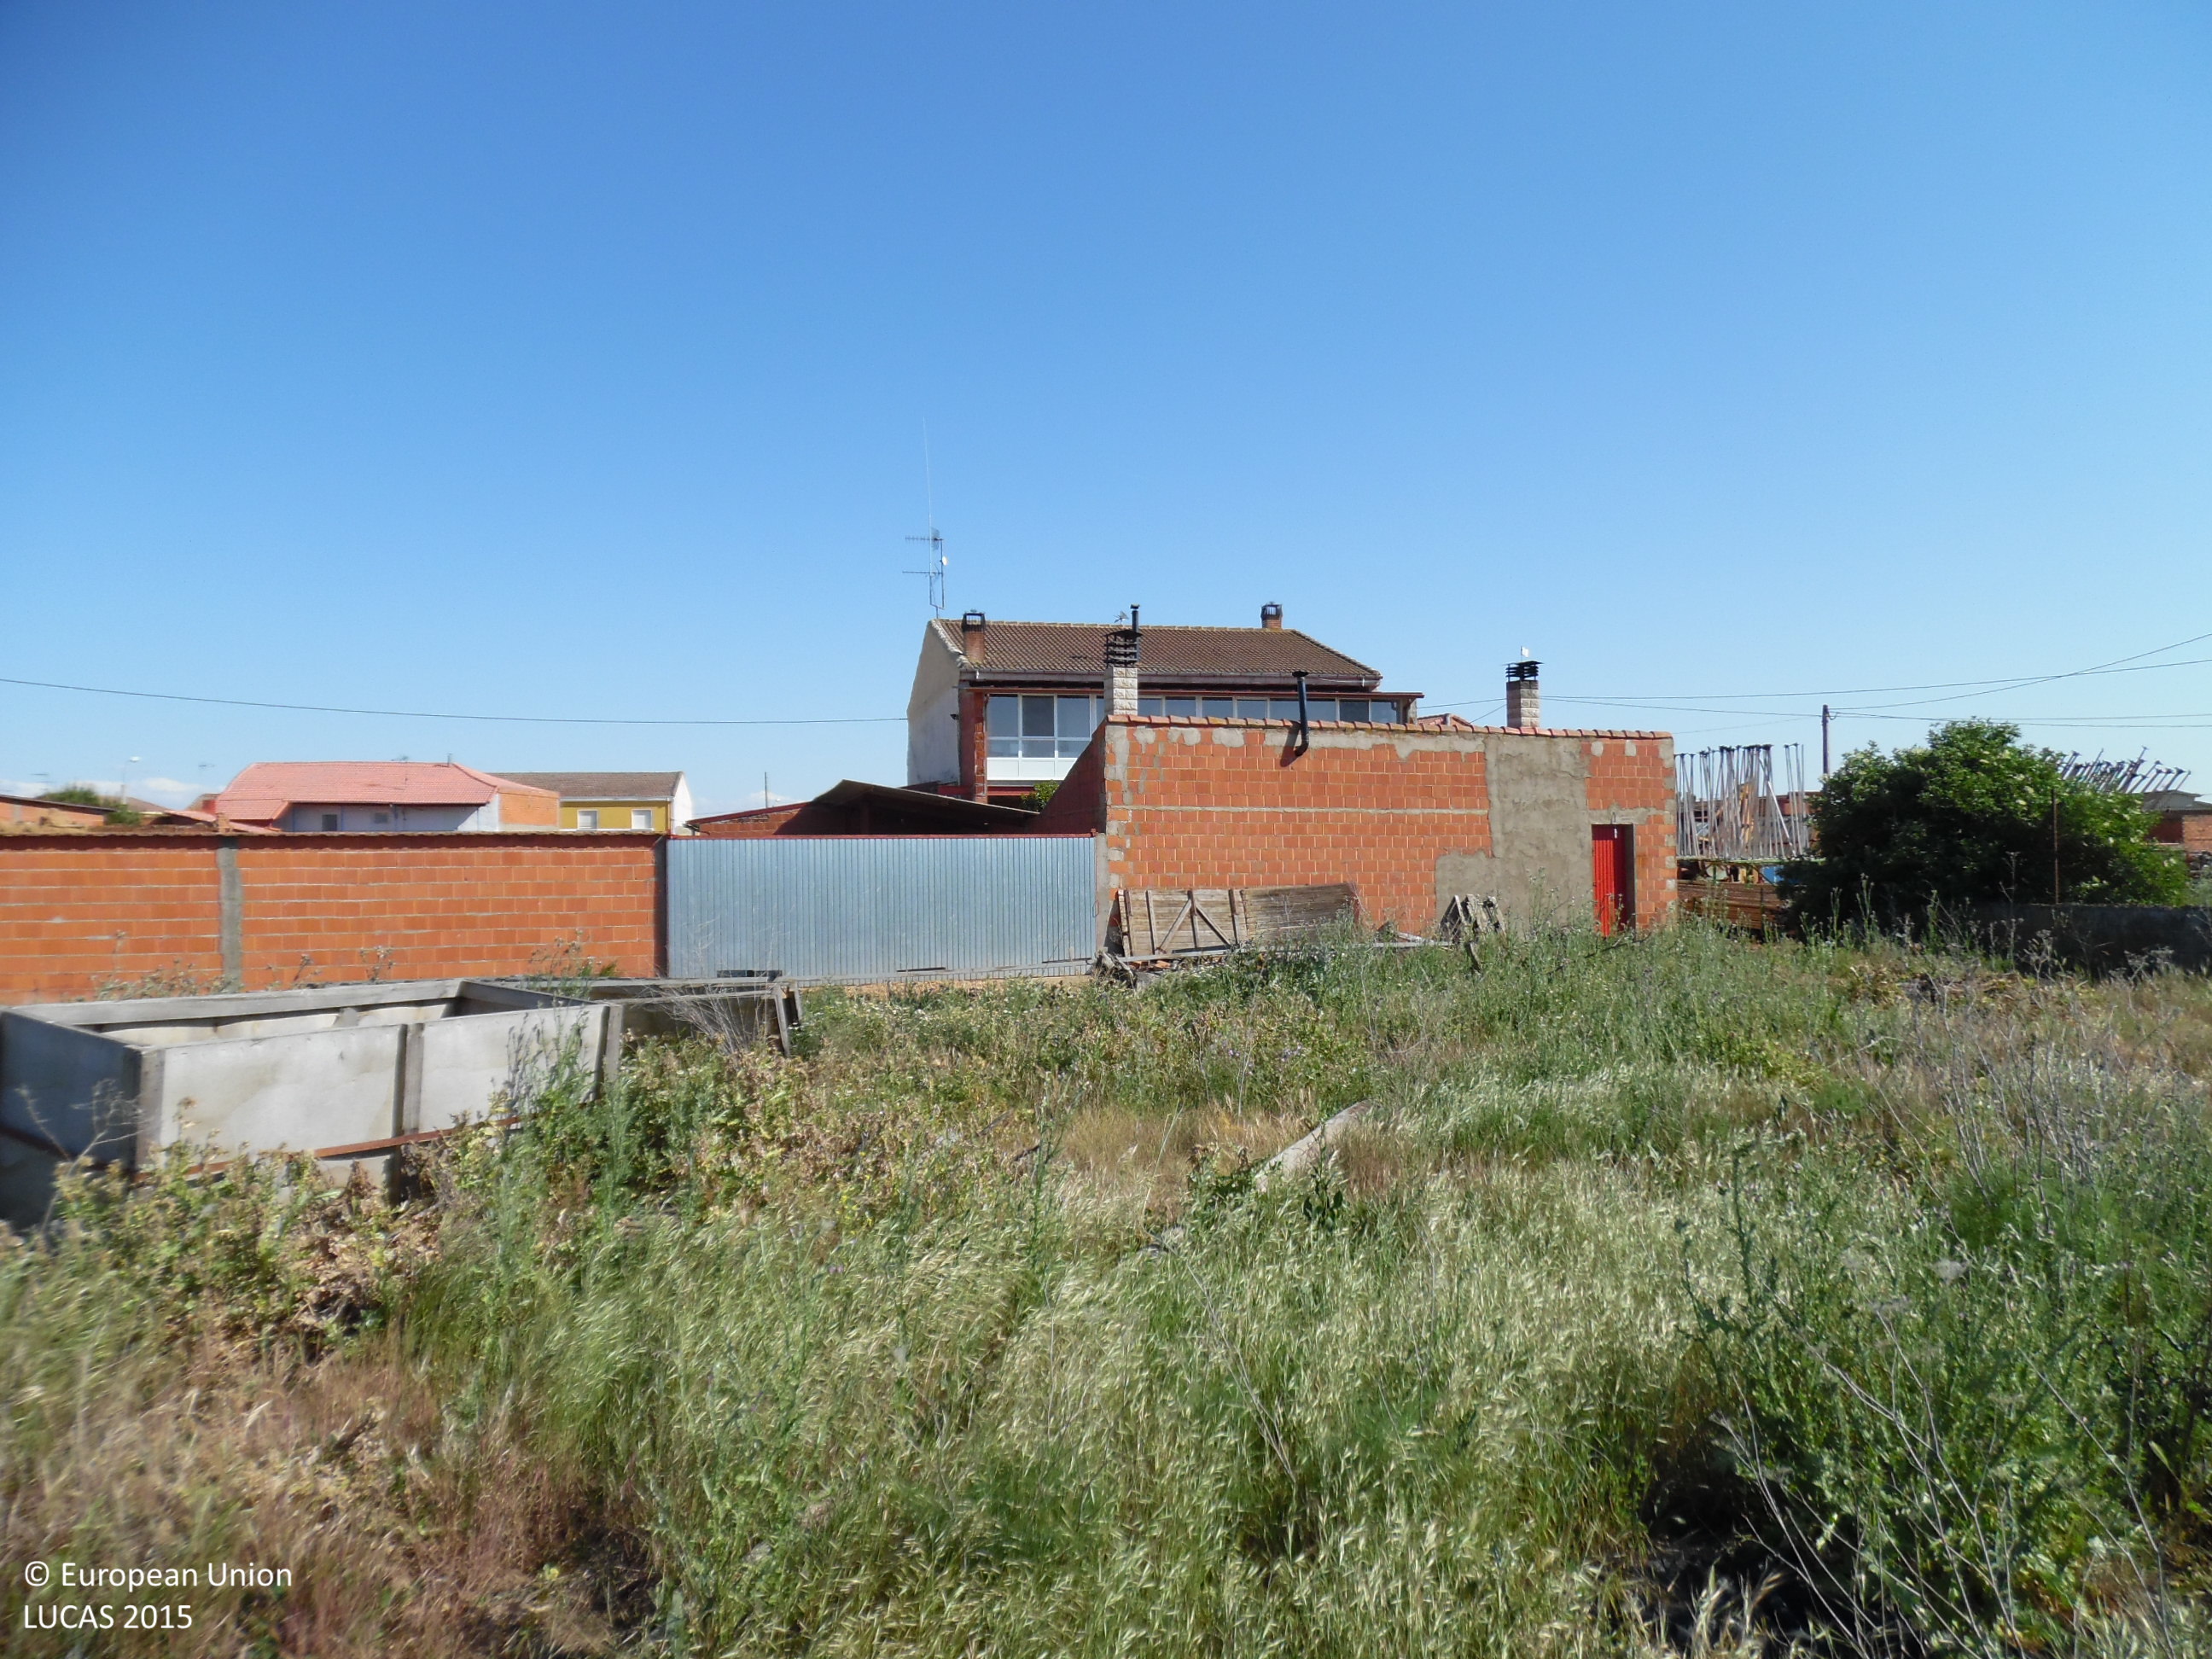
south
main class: Grassland
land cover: Grassland without tree/shrub cover
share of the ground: > 75 %
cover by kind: herbaceous plants 95 %, shrubs 5 %
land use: Abandoned areas
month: May
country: ES
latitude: 42.2443
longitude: -5.7175
